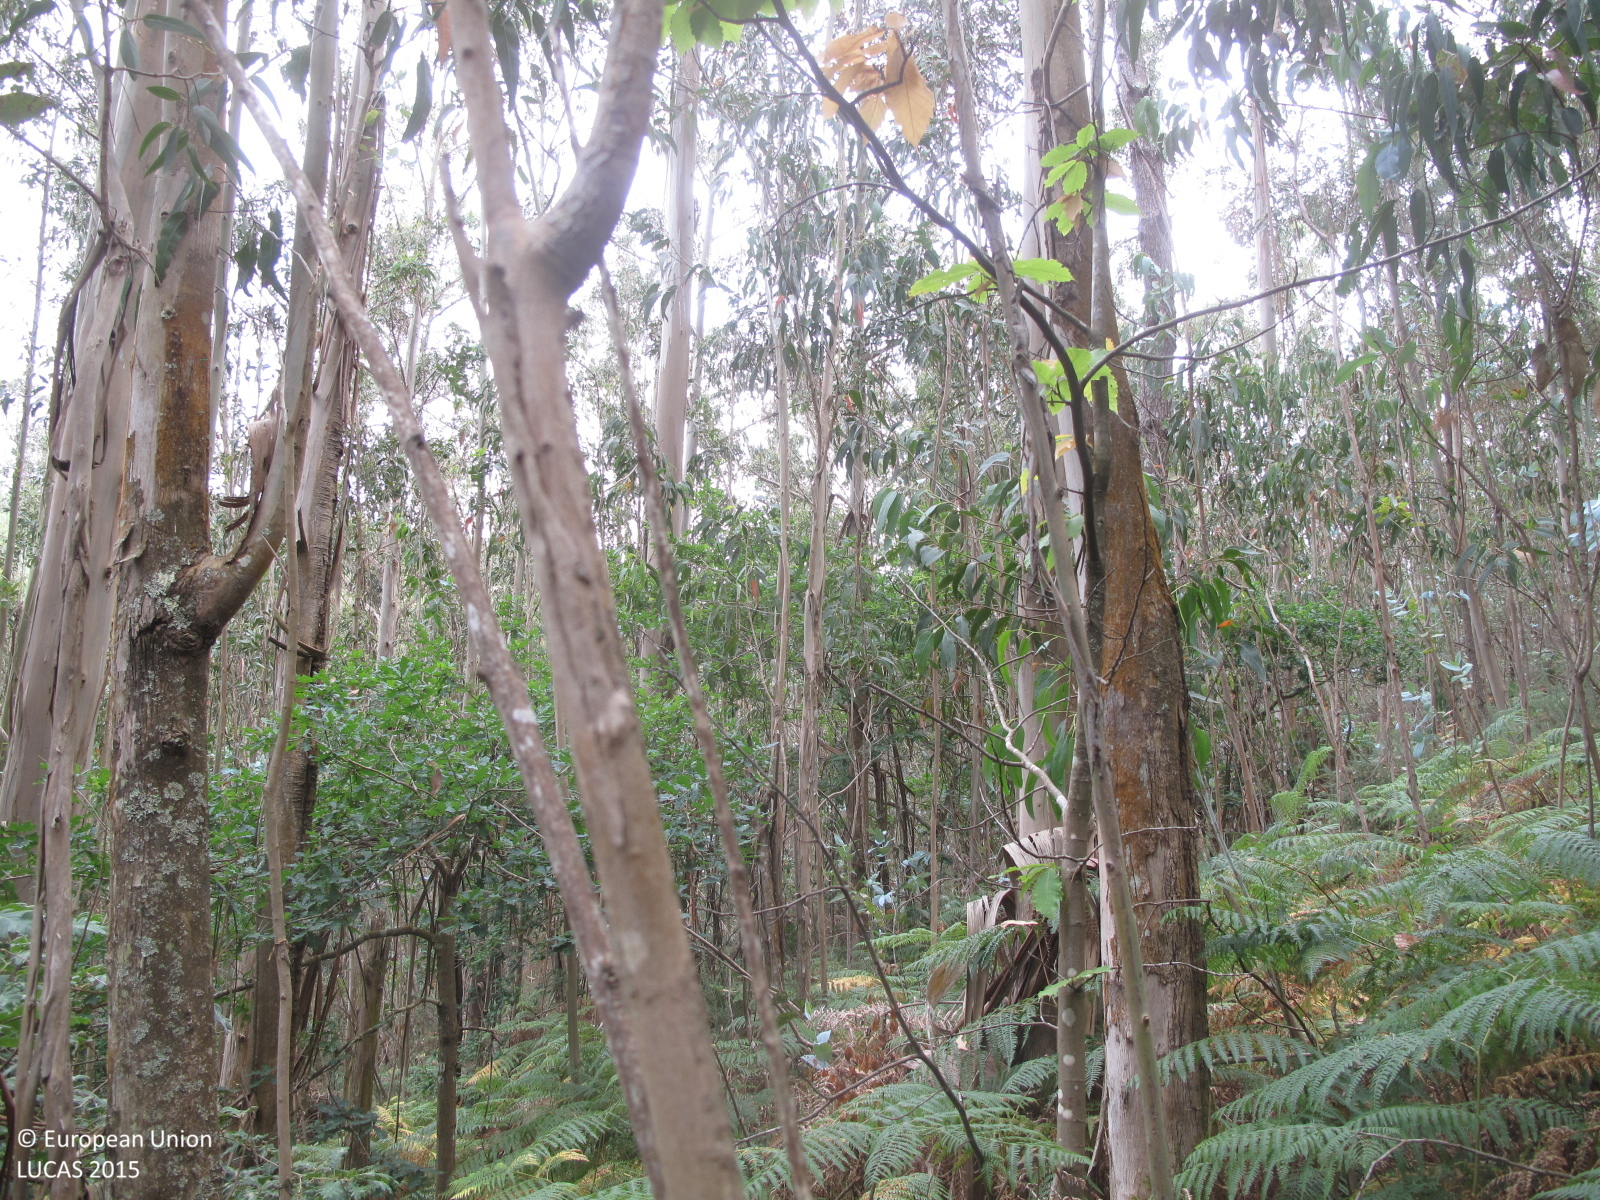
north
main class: Woodland
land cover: Other mixed woodland
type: exotic forest
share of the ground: 50 - 75 %
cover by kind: broadleaved forest trees 40 %, herbaceous plants 30 %, coniferous forest trees 20 %, shrubs 10 %
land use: Forestry
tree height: > 5 m
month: July
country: ES
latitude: 43.2946
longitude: -8.6135
